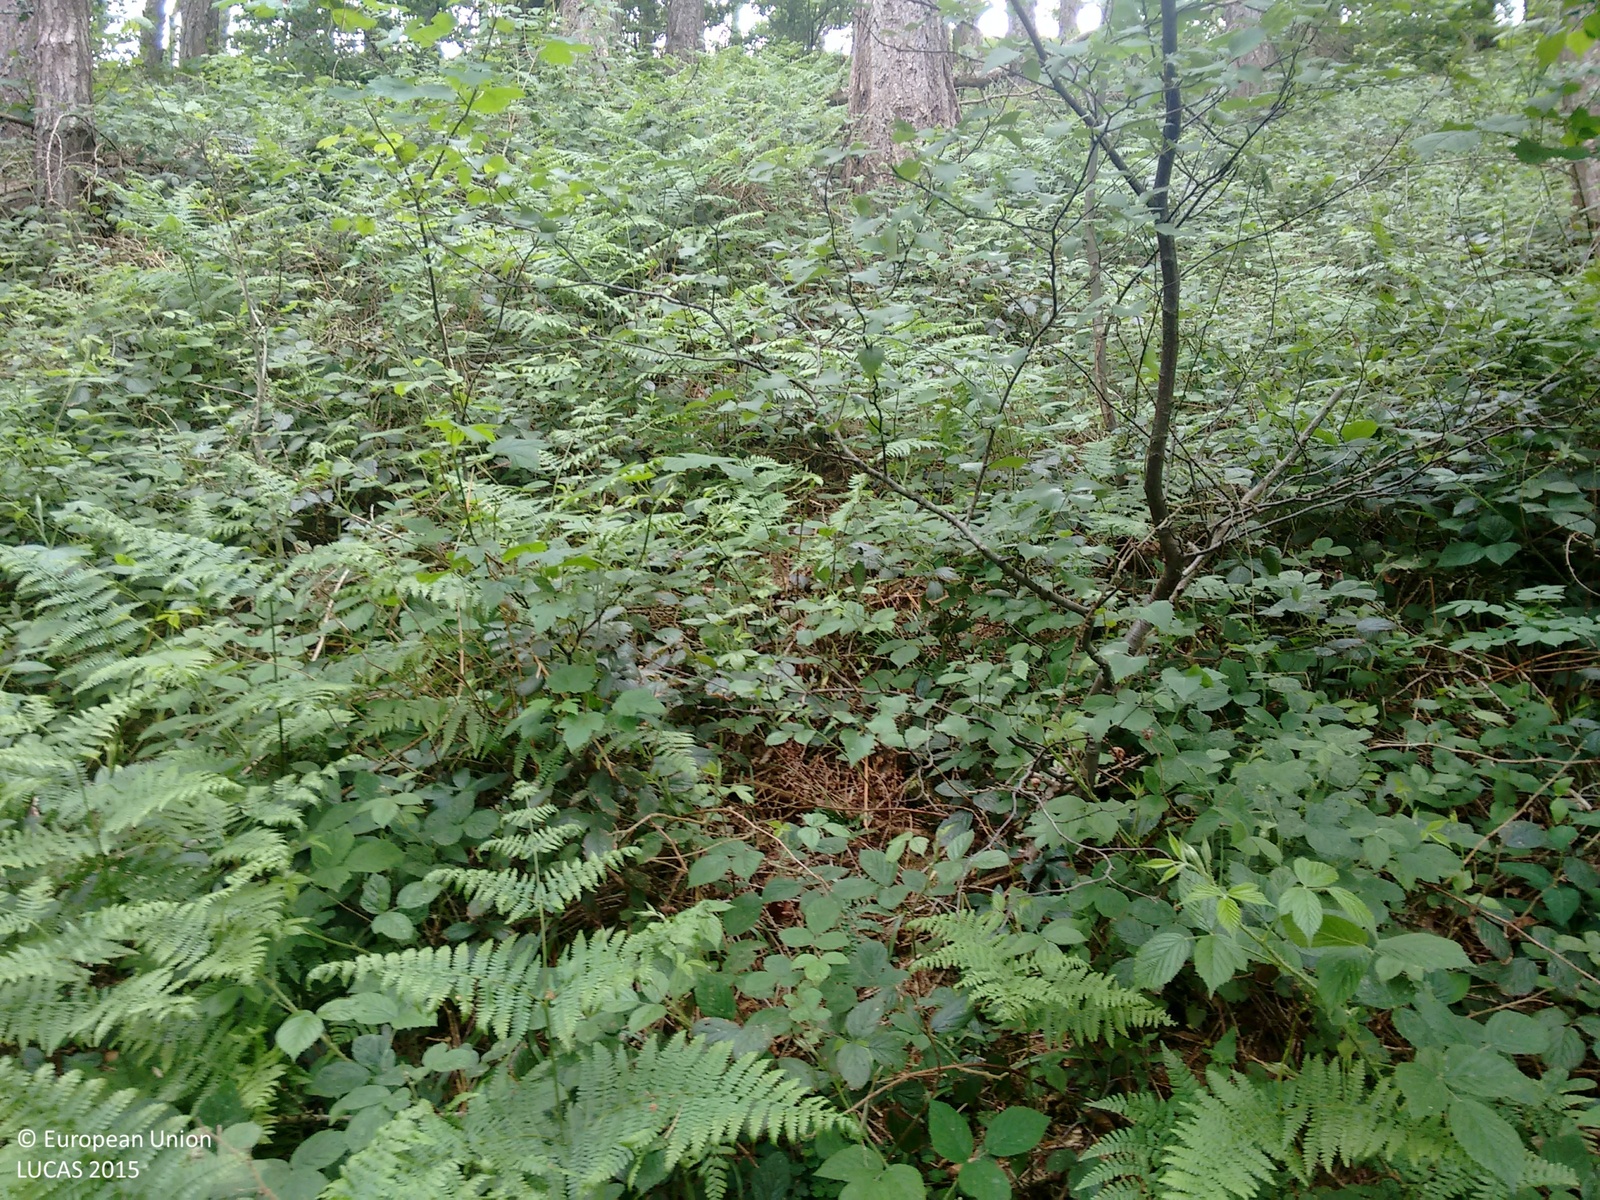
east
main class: Woodland
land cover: Pine dominated mixed woodland
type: exotic forest
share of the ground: > 75 %
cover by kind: coniferous forest trees 70 %, broadleaved forest trees 30 %
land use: Forestry
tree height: > 5 m
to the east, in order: Pine dominated mixed woodland; Tracks; Pine dominated mixed woodland; Fences; Grassland without tree/shrub cover; Fences; Managed hedges; Fences; Grass margins; Oats; Grassland without tree/shrub cover; Managed hedges; Grass margins; Paved roads, cycling and walking lanes; Grass margins; Managed hedges; Grassland without tree/shrub cover
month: June
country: GB
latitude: 54.2712
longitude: -1.0840
